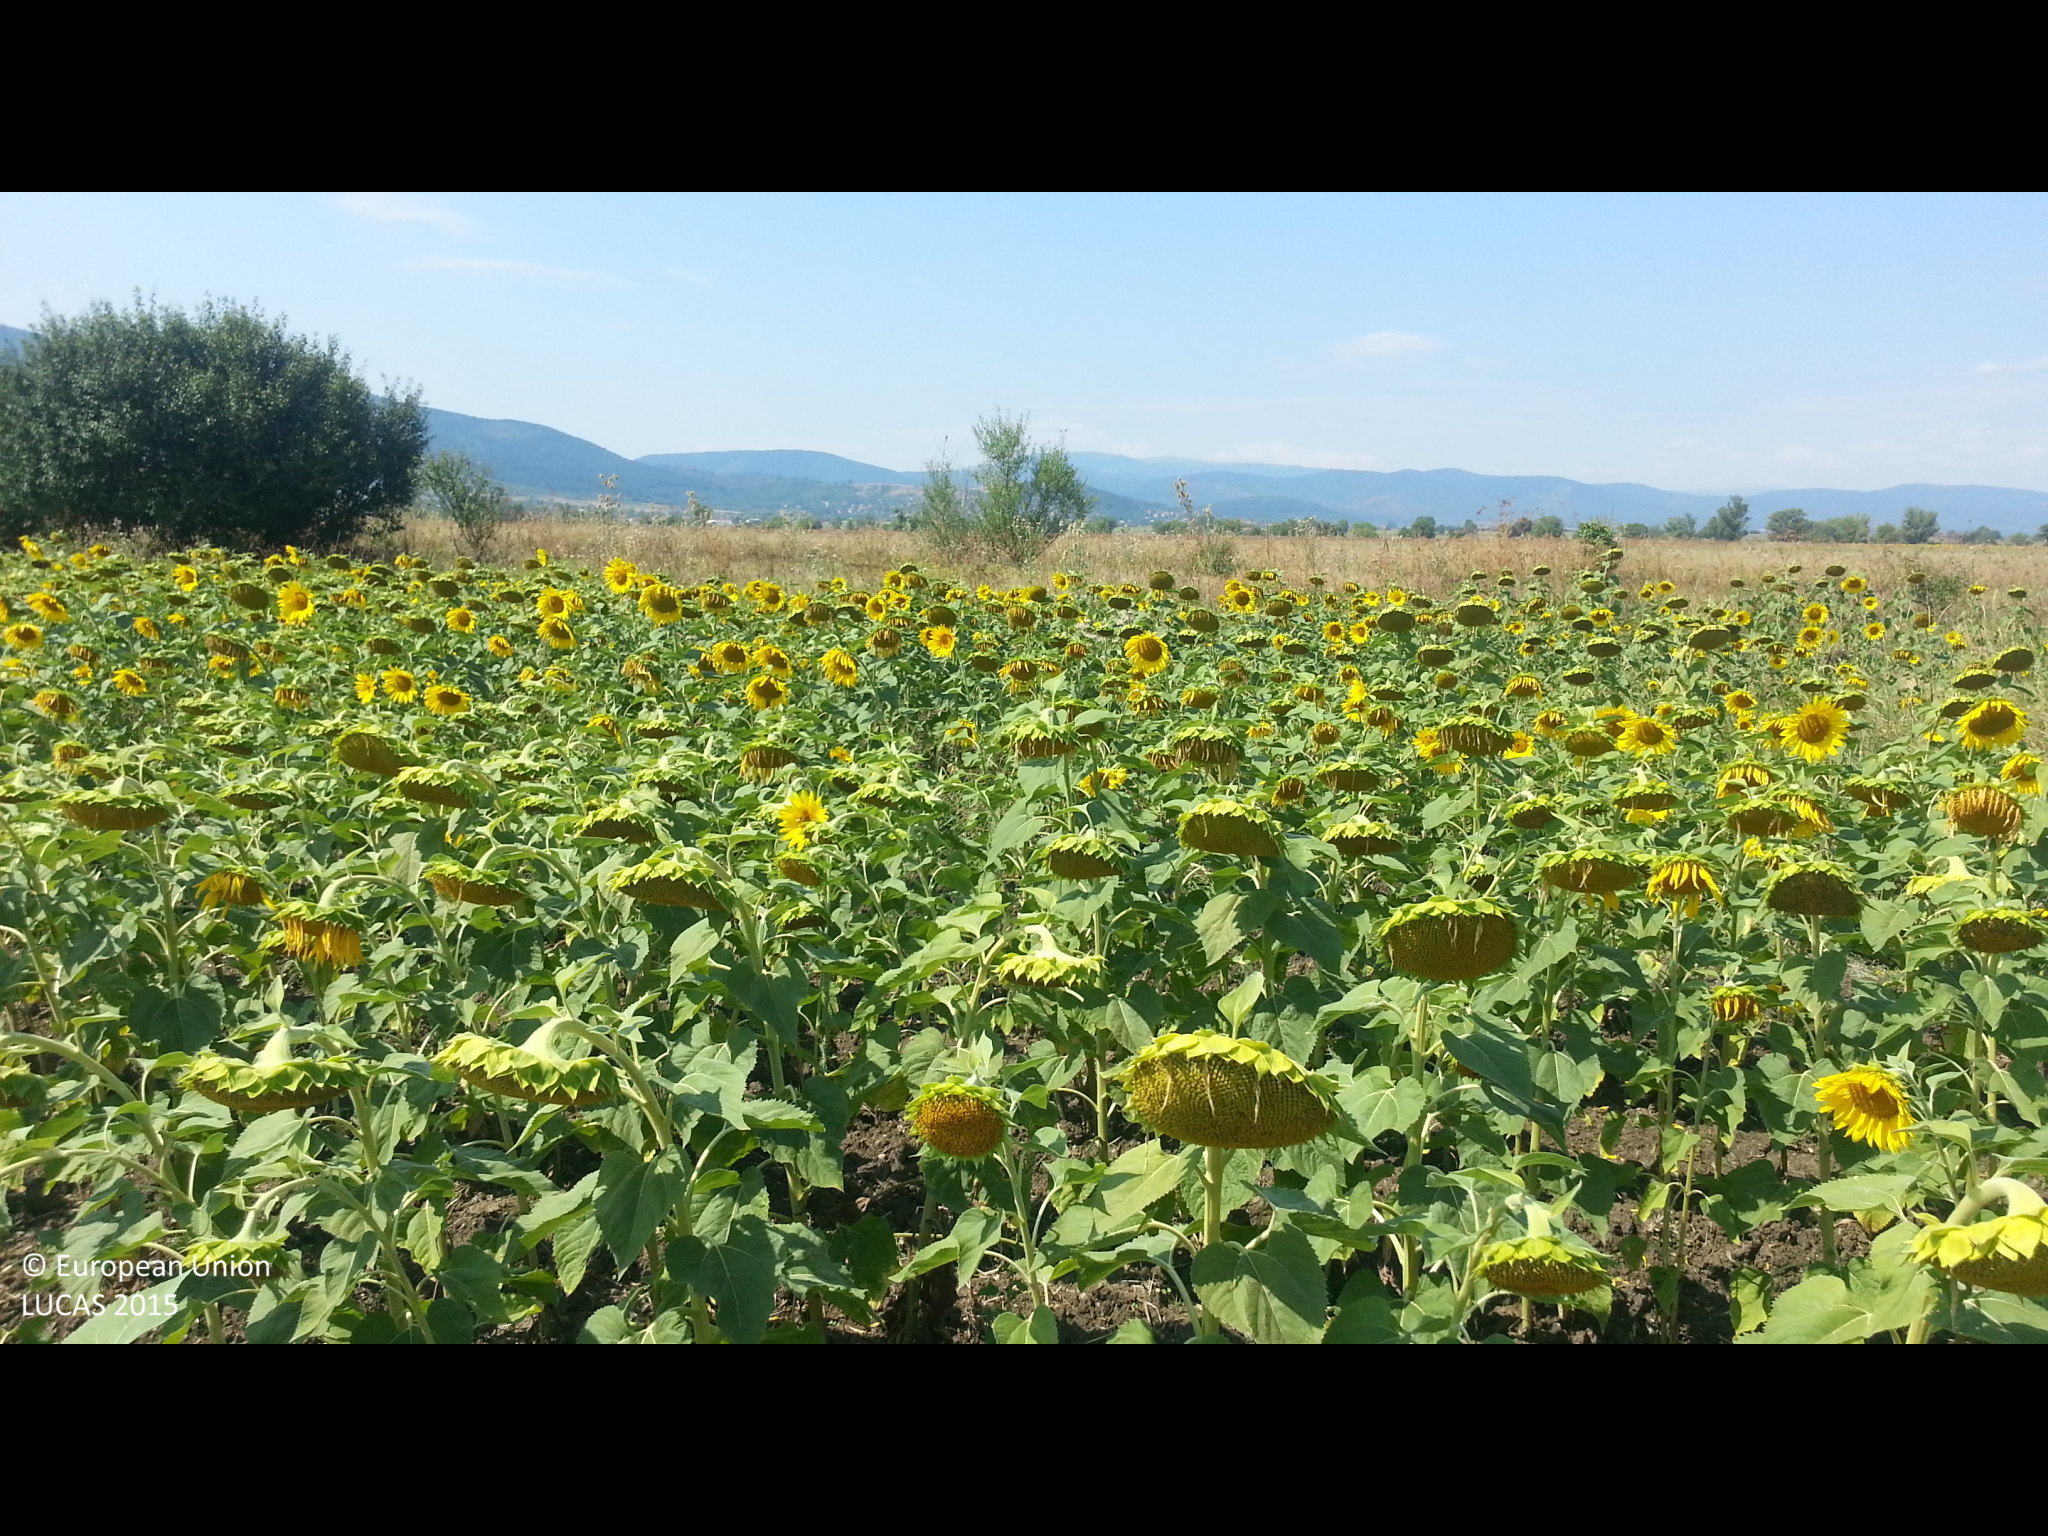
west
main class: Cropland
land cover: Sunflower
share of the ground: > 75 %
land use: Agriculture (excluding fallow land and kitchen gardens)
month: August
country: BG
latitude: 42.4399
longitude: 22.9494
